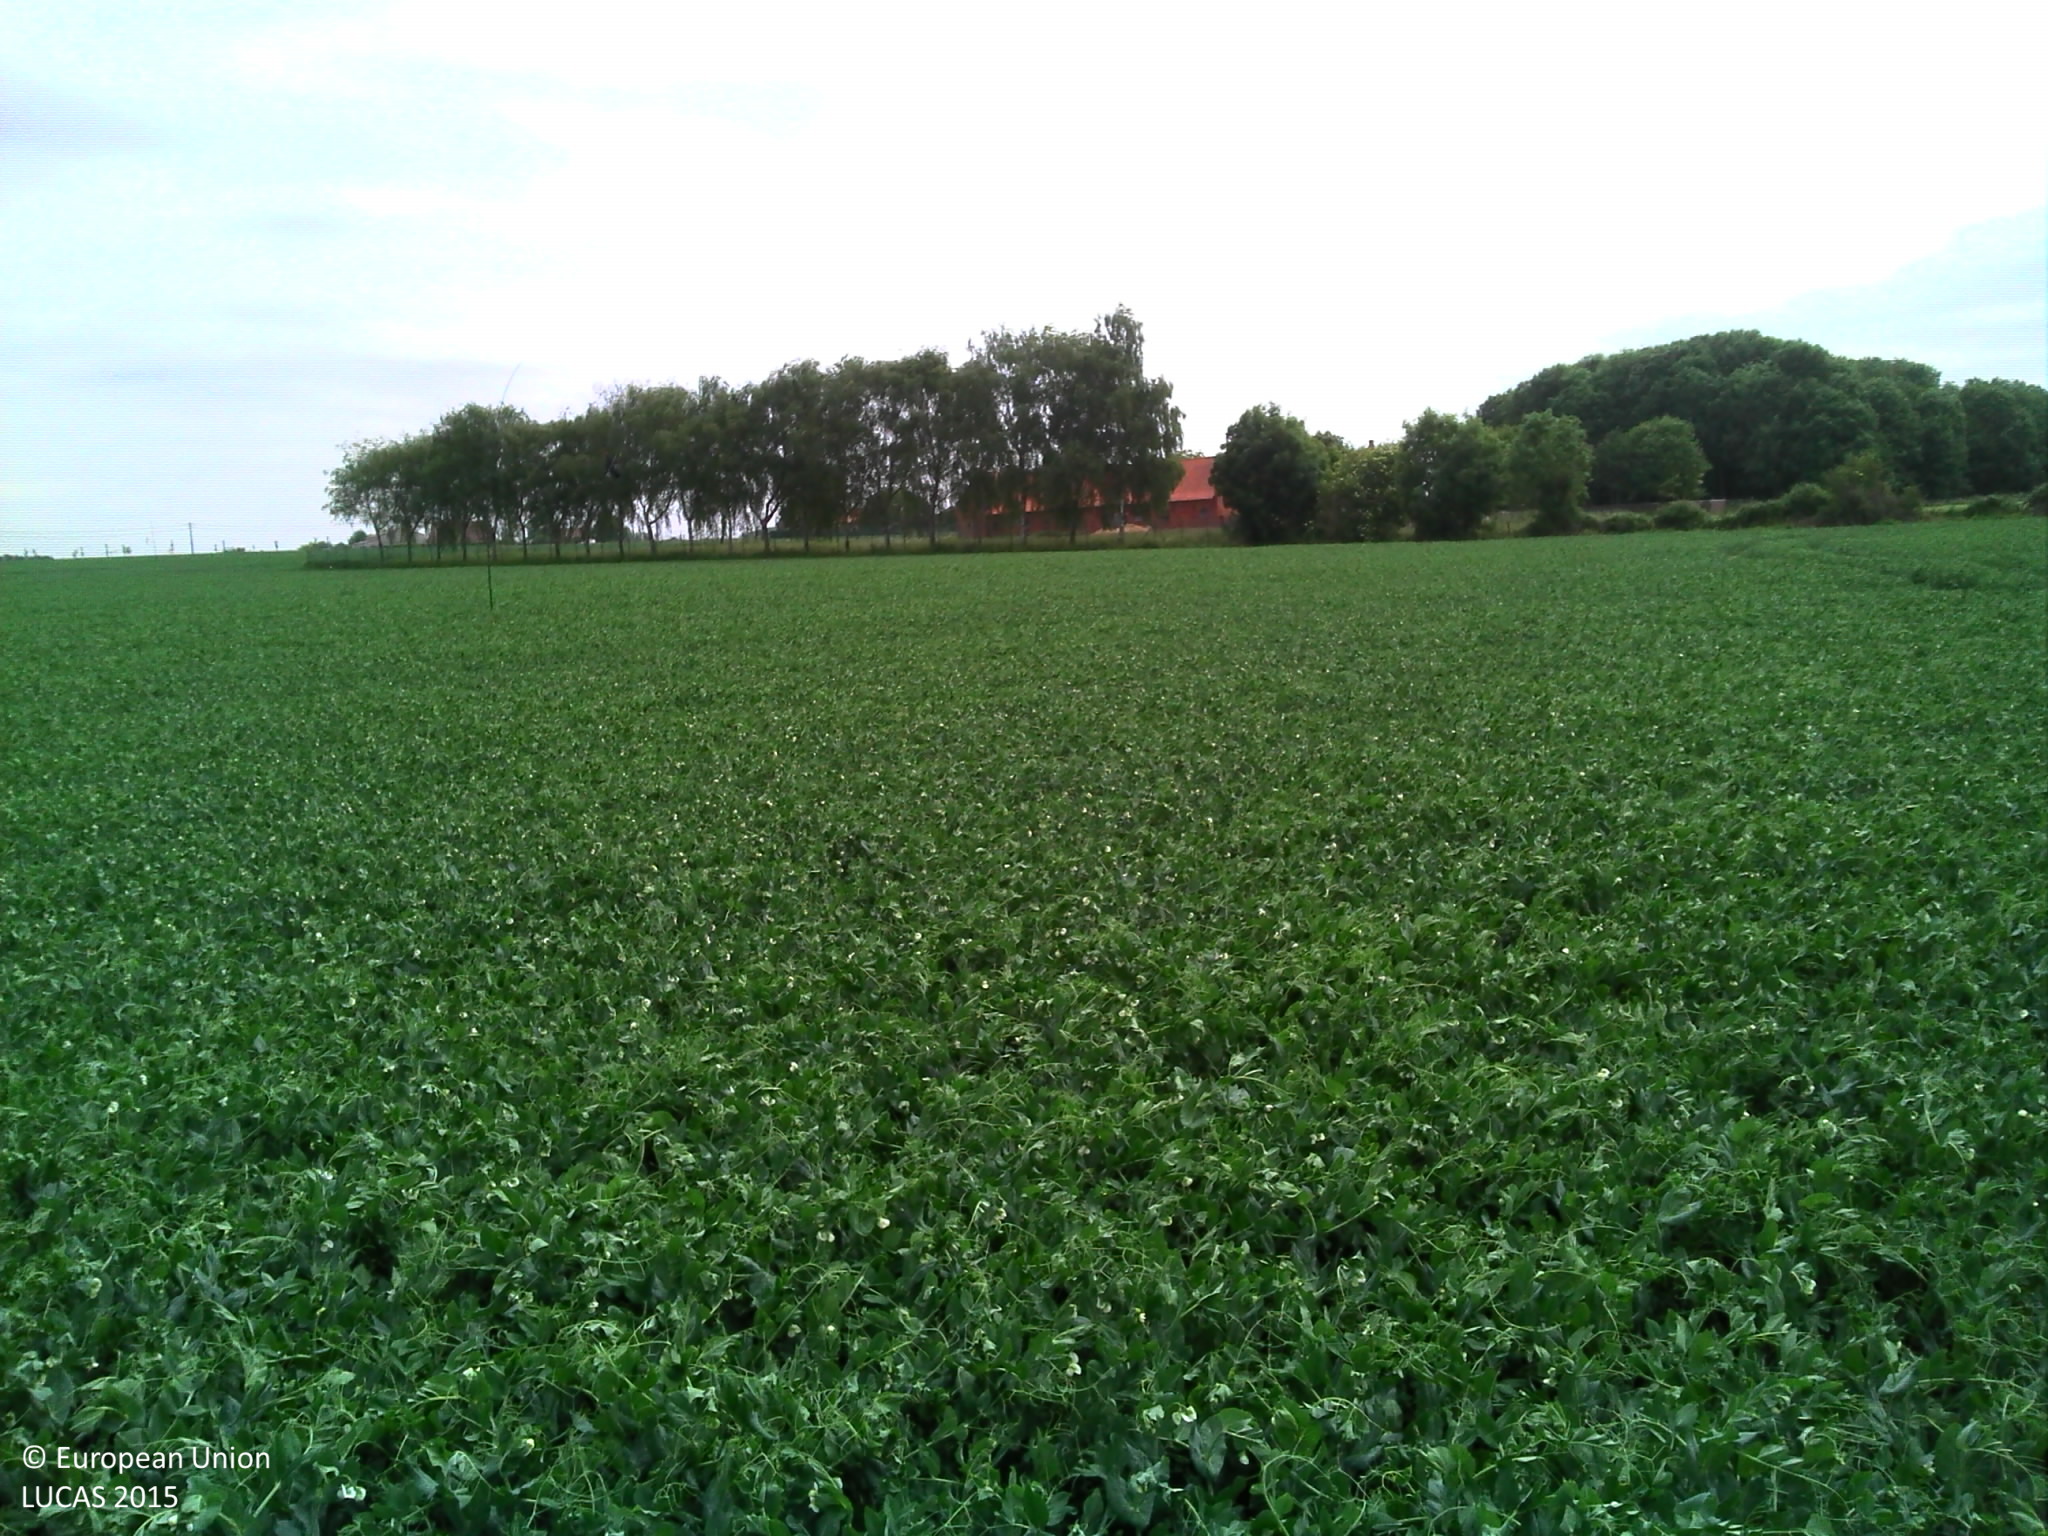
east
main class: Cropland
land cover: Dry pulses
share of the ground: > 75 %
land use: Agriculture (excluding fallow land and kitchen gardens)
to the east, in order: Dry pulses; Fences; Lines of trees; Grassland without tree/shrub cover; Artificial constructions in urban areas; Grassland without tree/shrub cover
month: June
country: BE
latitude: 50.8296
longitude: 2.9048
